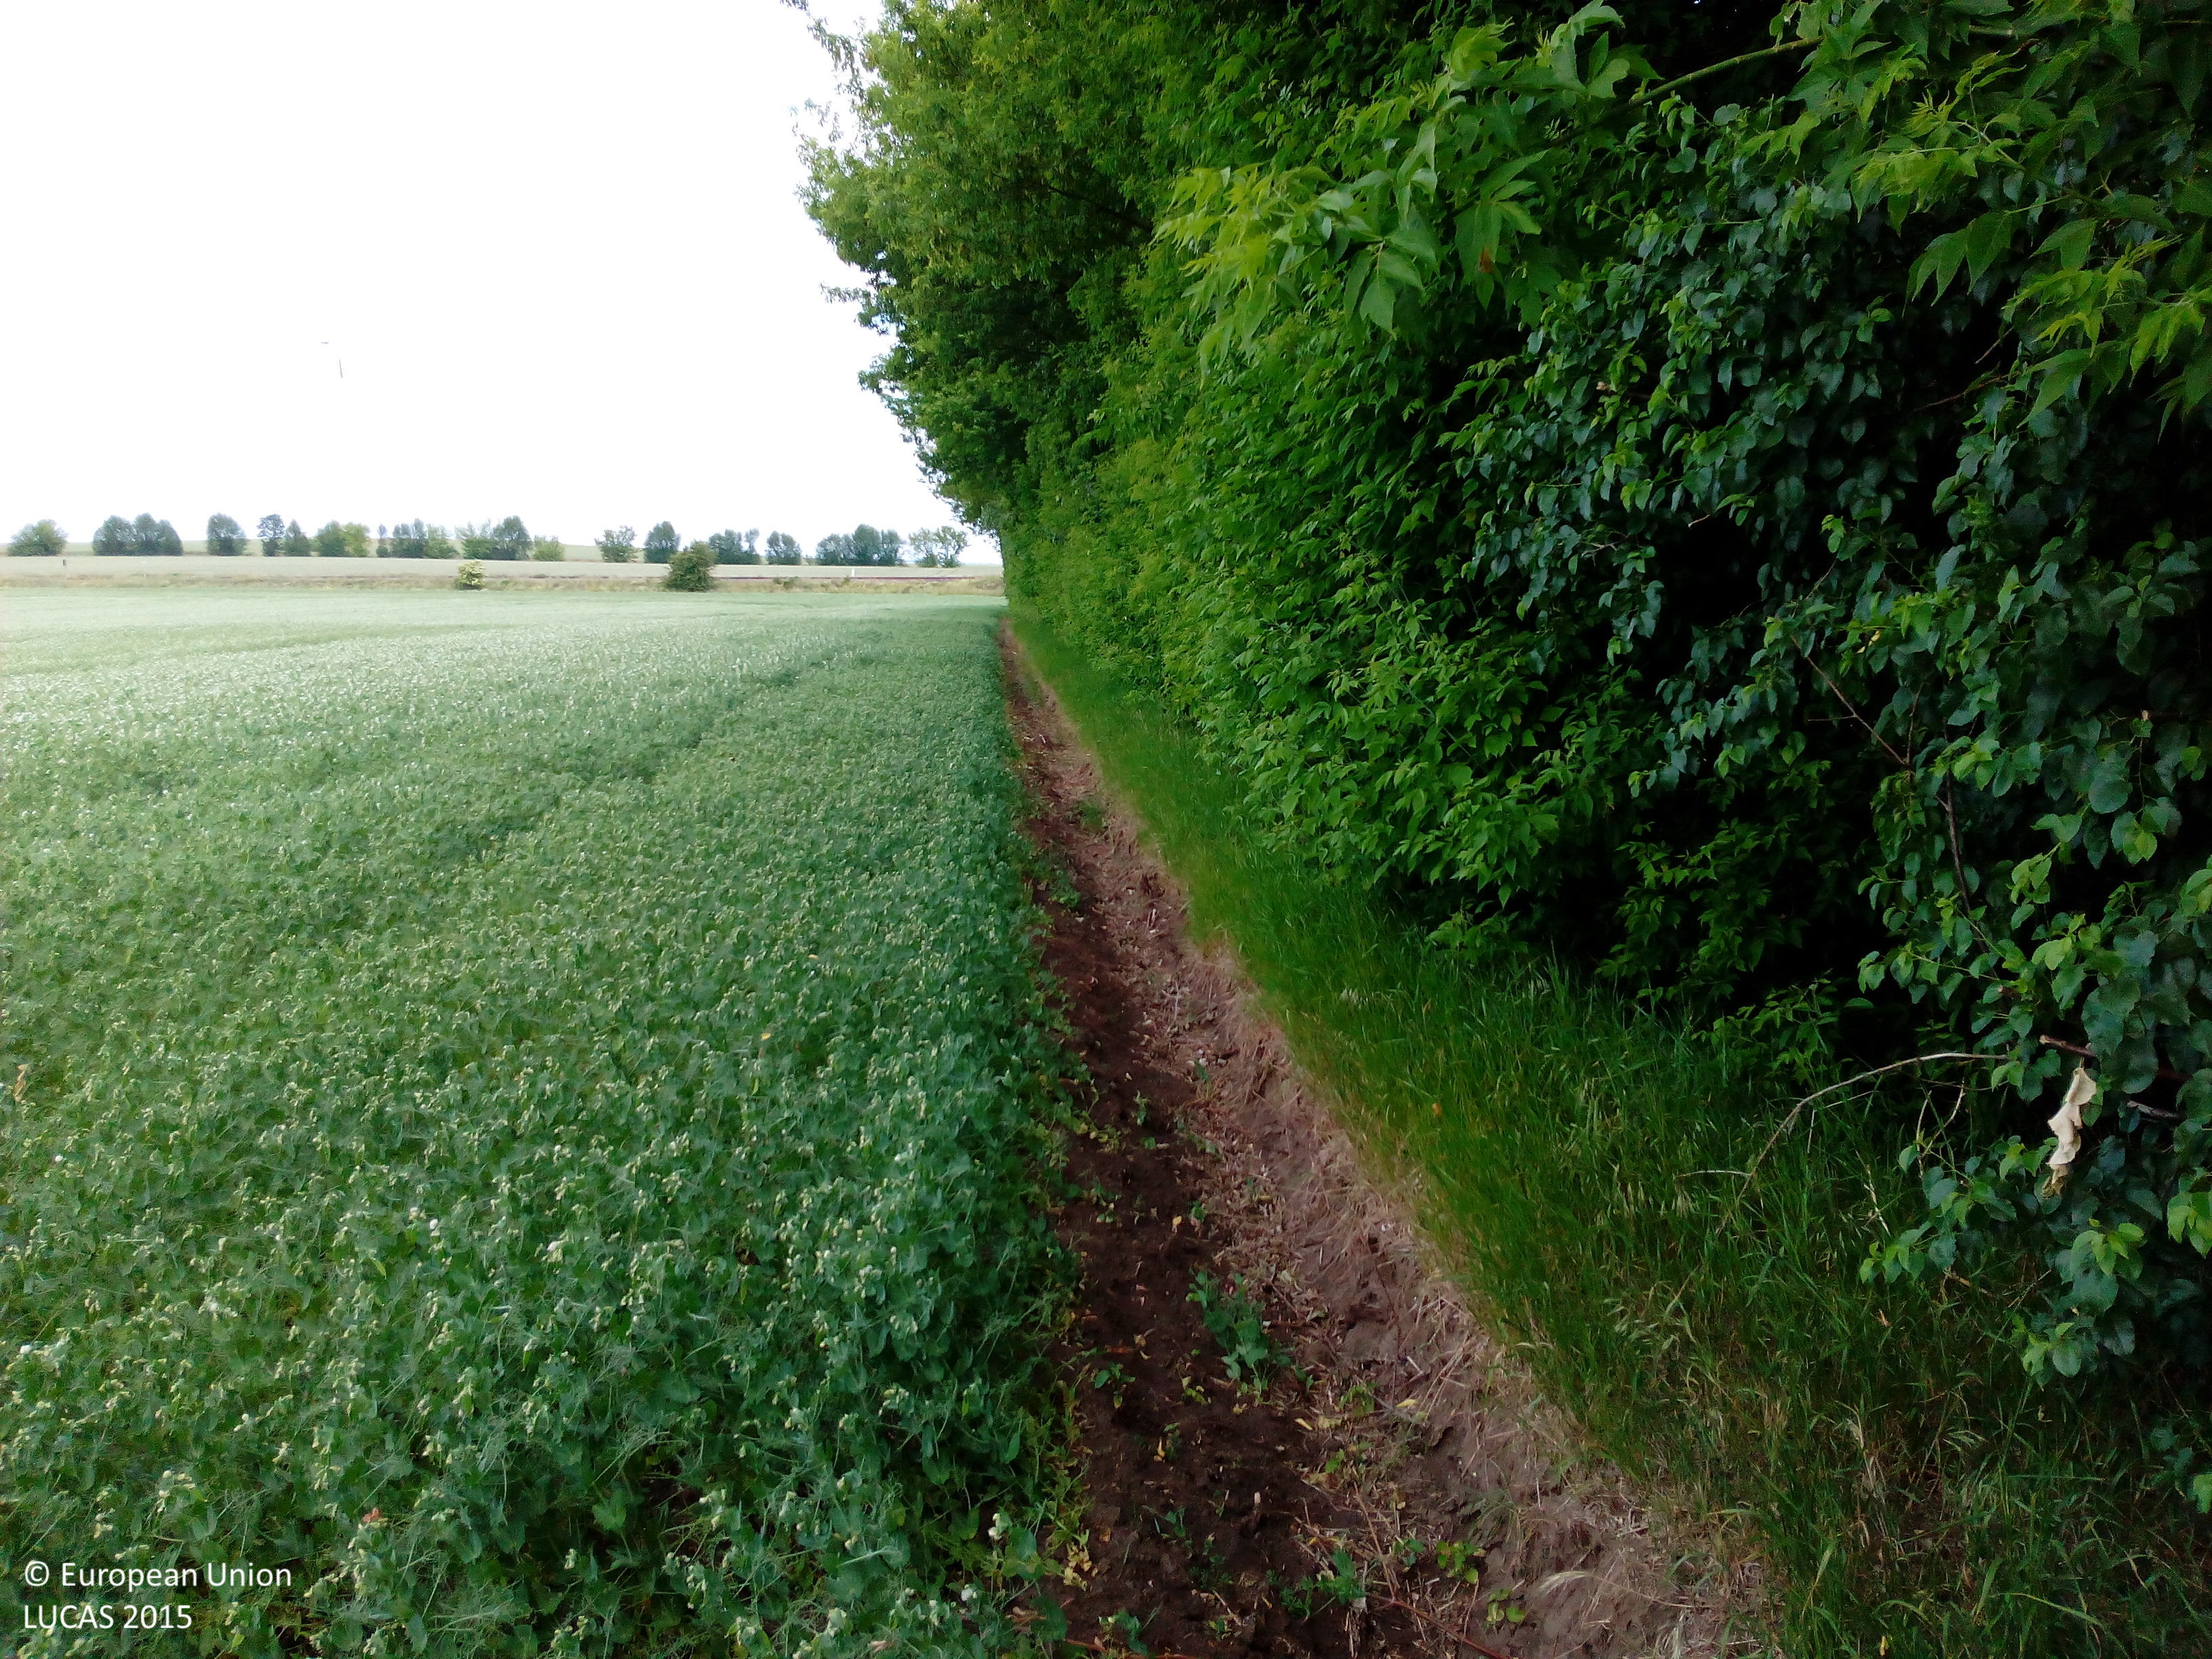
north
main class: Cropland
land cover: Dry pulses
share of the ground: > 75 %
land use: Agriculture (excluding fallow land and kitchen gardens)
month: June
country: DE
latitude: 51.8868
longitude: 11.1184
